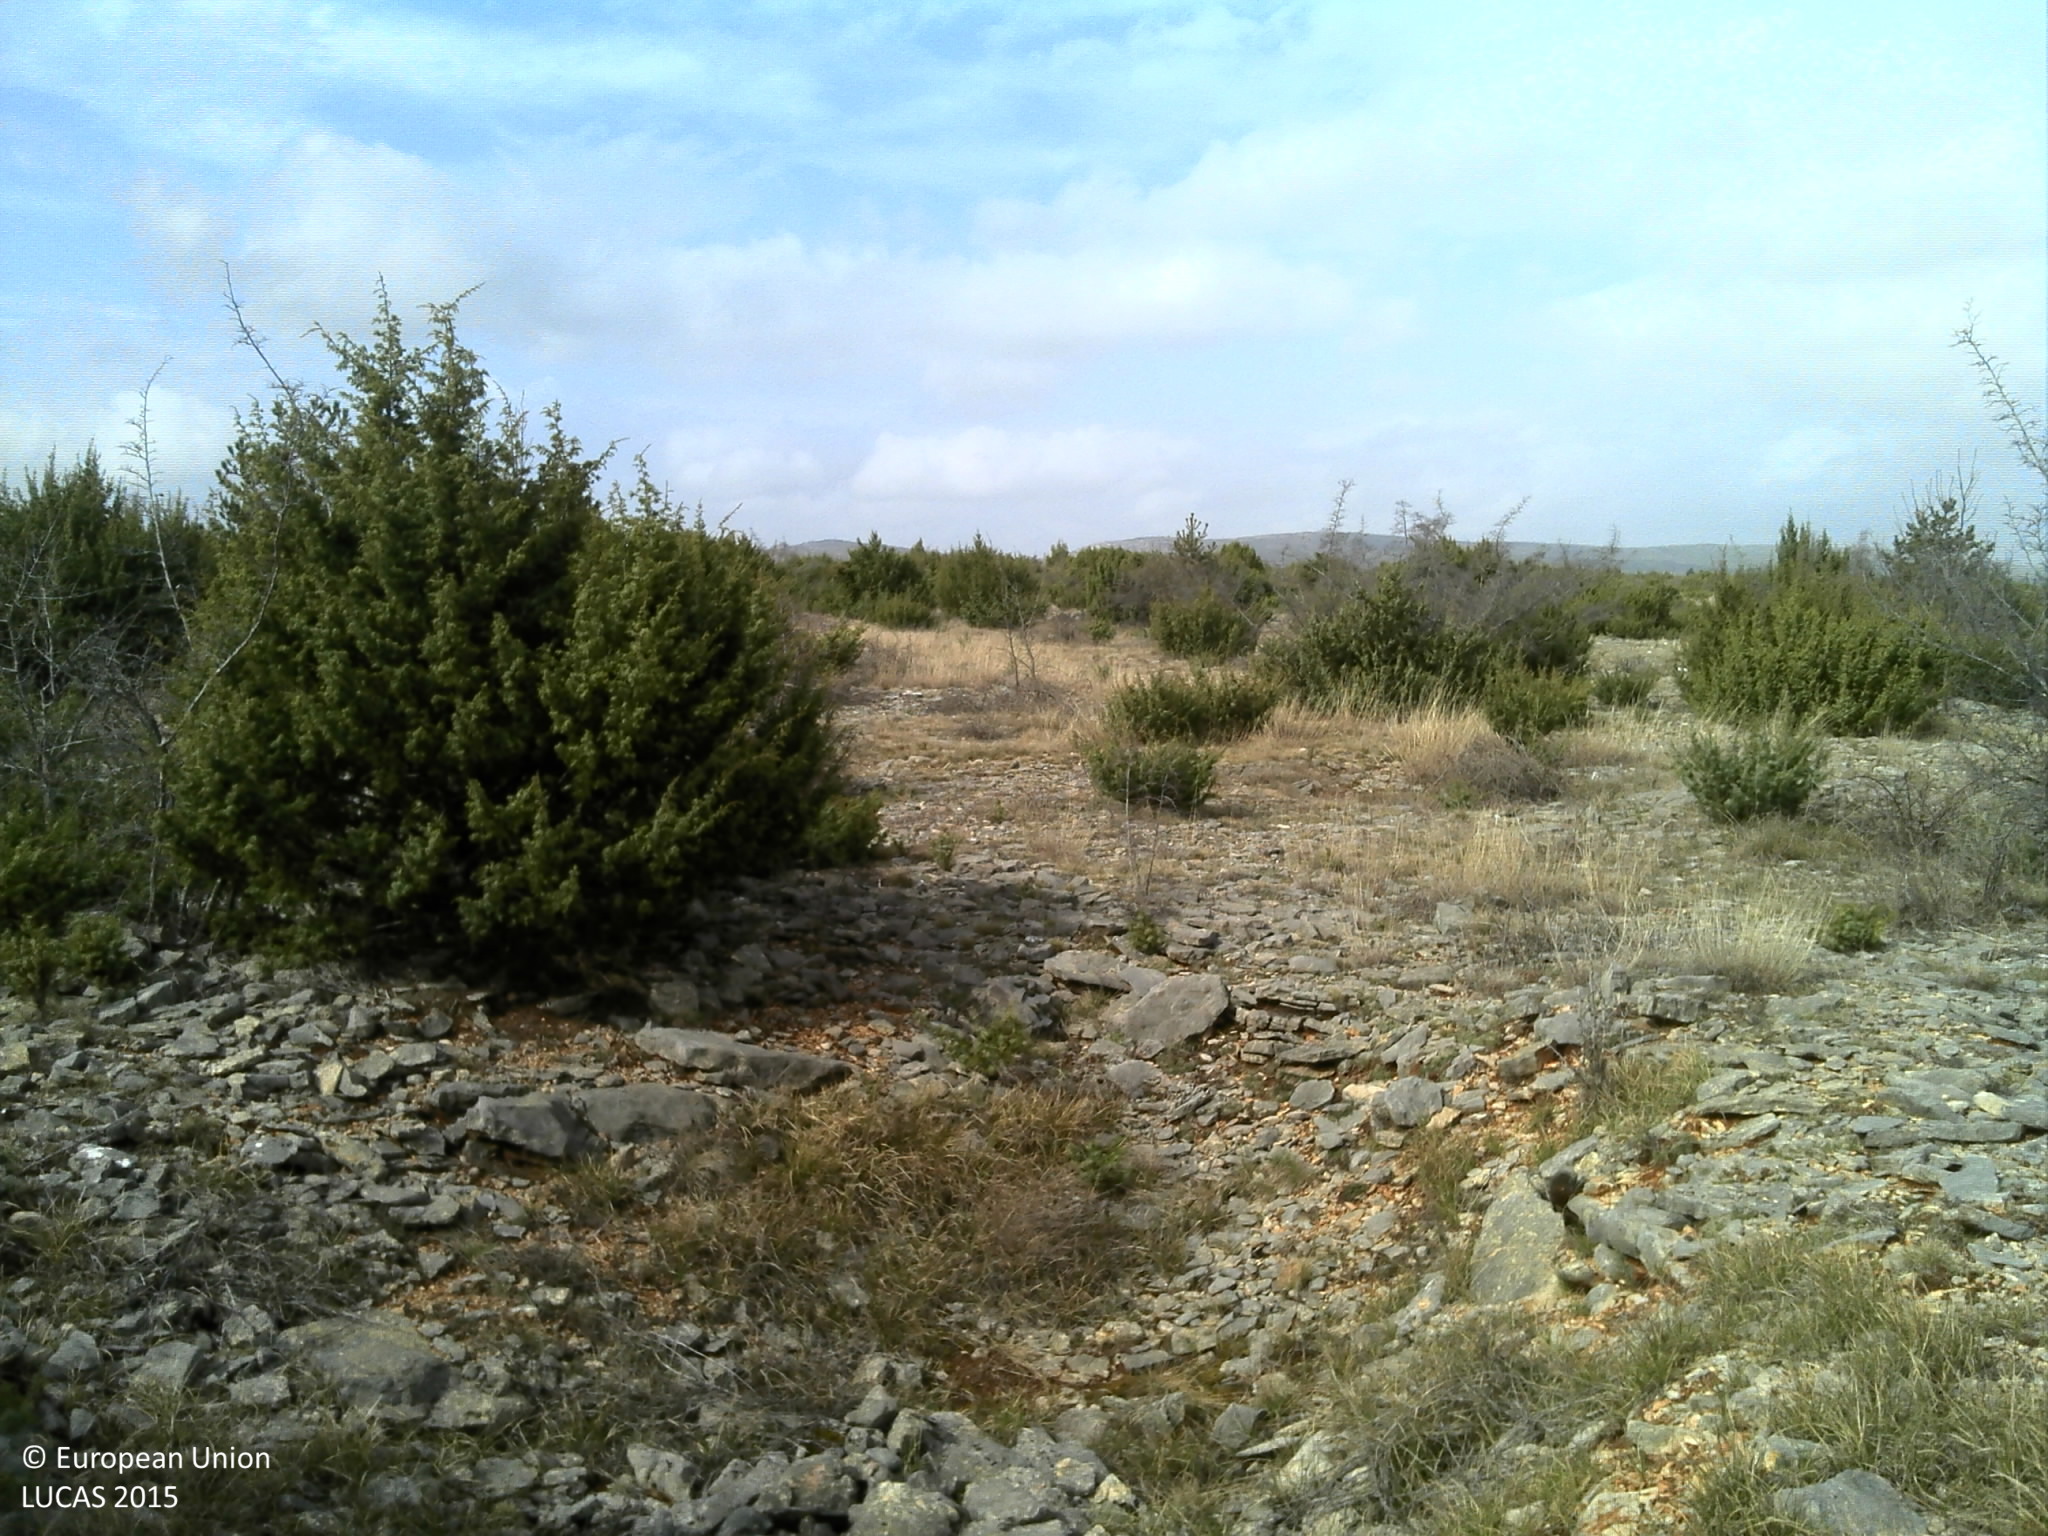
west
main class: Shrubland
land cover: Shrubland with sparse tree cover
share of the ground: 25 - 50 %
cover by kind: shrubs 30 %, unconsolidated bare surface 30 %, consolidated bare surface 10 %, broadleaved forest trees 5 %
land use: Semi-natural and natural areas not in use
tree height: < 5 m
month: March
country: HR
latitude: 43.9678
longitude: 15.8625
